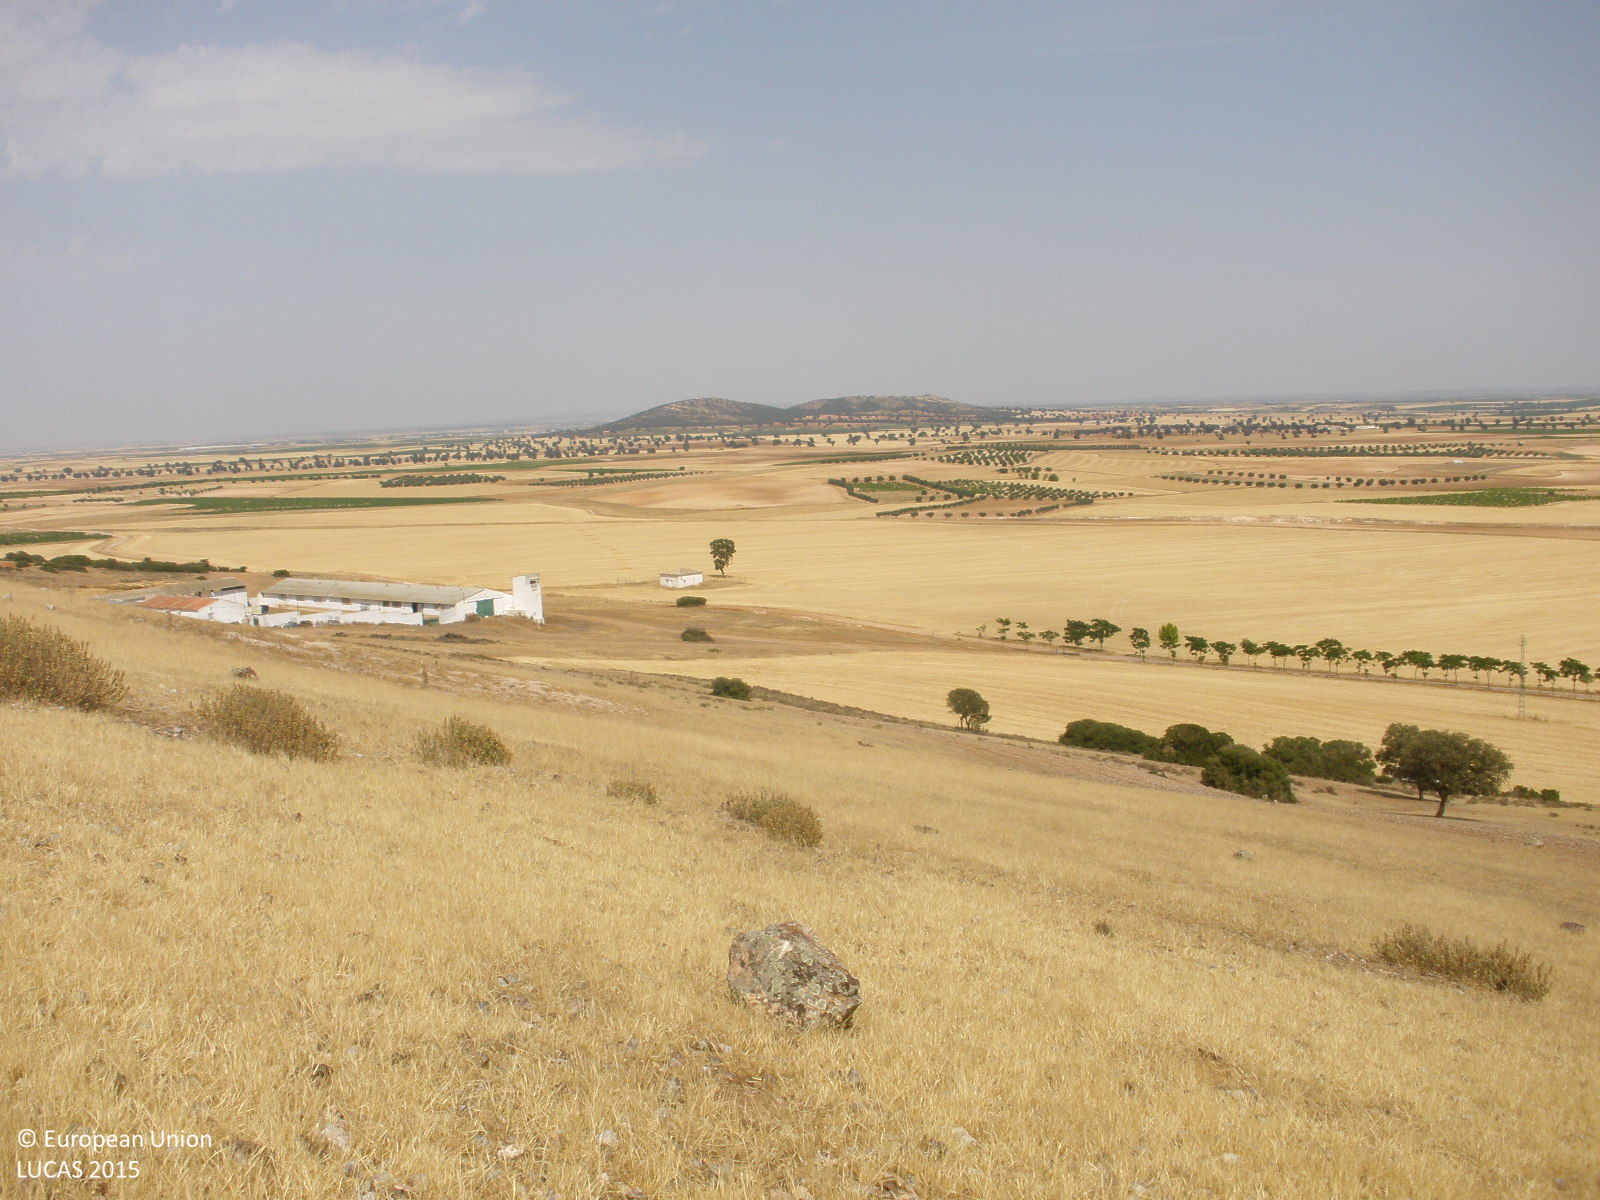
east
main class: Grassland
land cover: Grassland without tree/shrub cover
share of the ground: > 75 %
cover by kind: herbaceous plants 90 %, shrubs 5 %, consolidated bare surface 5 %
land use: Agriculture (excluding fallow land and kitchen gardens)
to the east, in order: Grassland without tree/shrub cover; Grassland with sparse tree/shrub cover; Tracks; Grassland with sparse tree/shrub cover; Barley
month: July
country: ES
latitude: 39.7430
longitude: -3.2920
